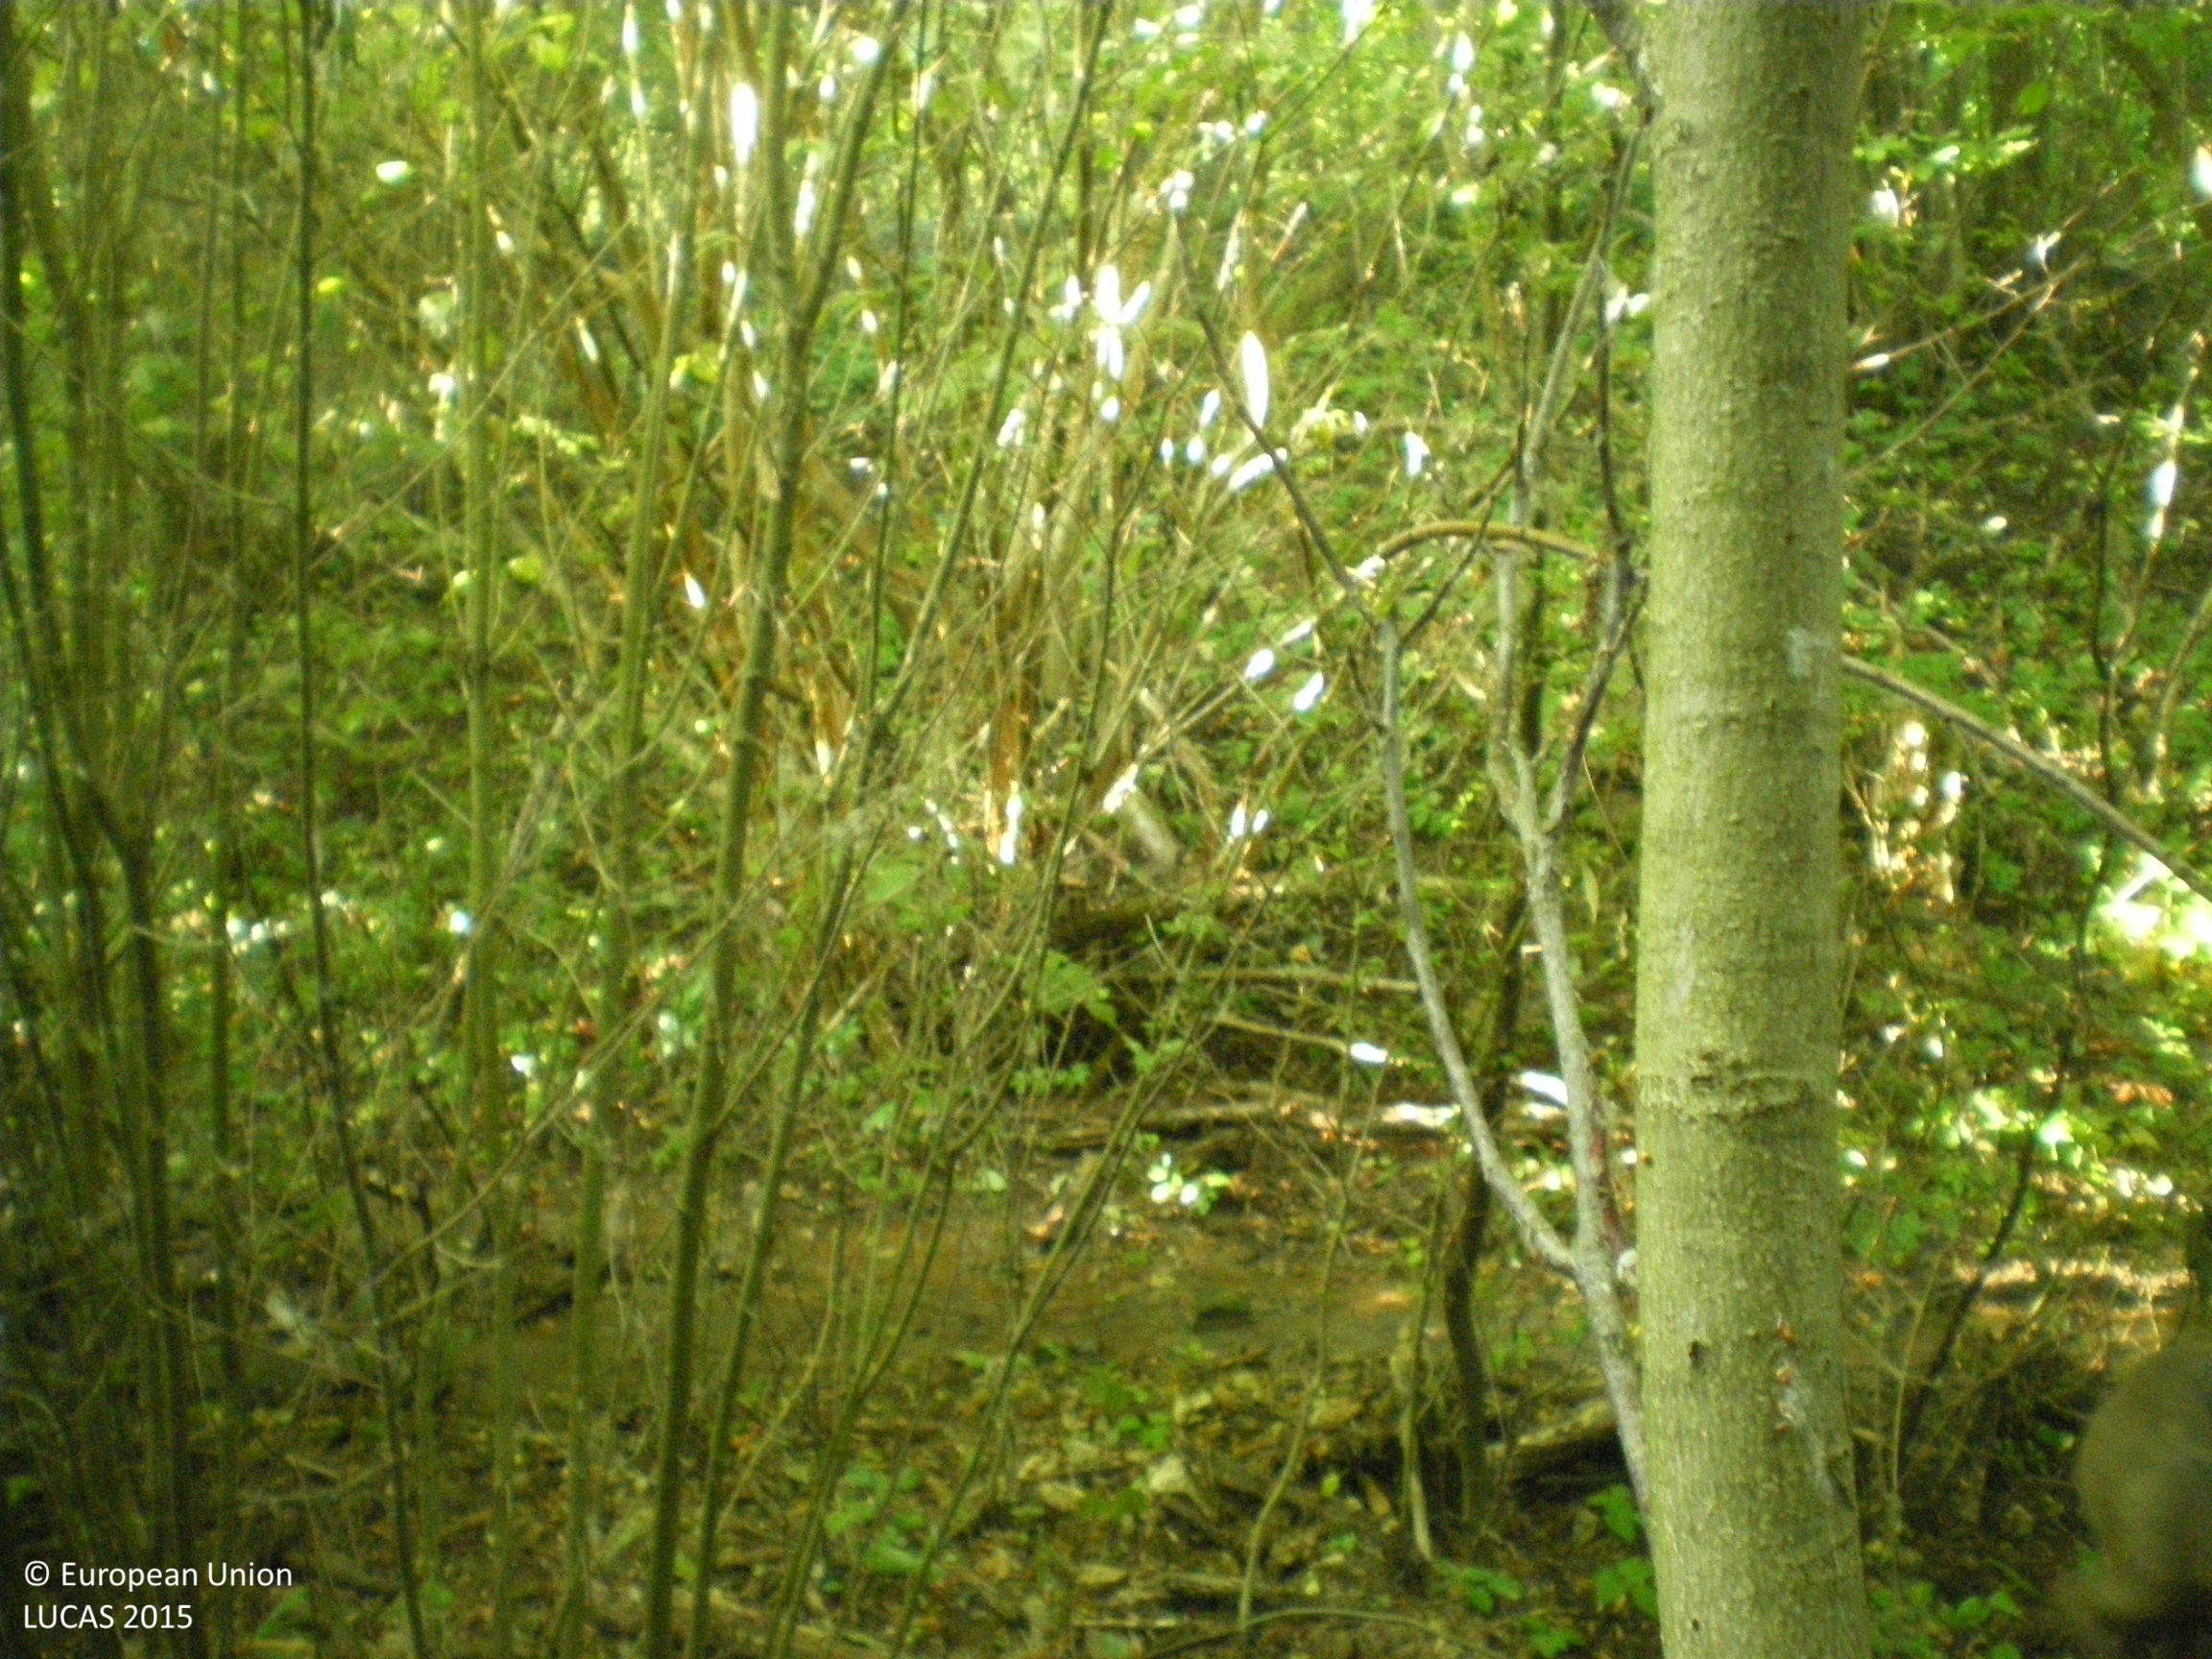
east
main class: Woodland
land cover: Broadleaved woodland
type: mesophytic deciduous forest
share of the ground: > 75 %
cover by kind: broadleaved forest trees 100 %
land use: Forestry
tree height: > 5 m
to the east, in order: Broadleaved woodland; Rivers and streams; Broadleaved woodland
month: August
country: BG
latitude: 42.3910
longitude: 25.4836
